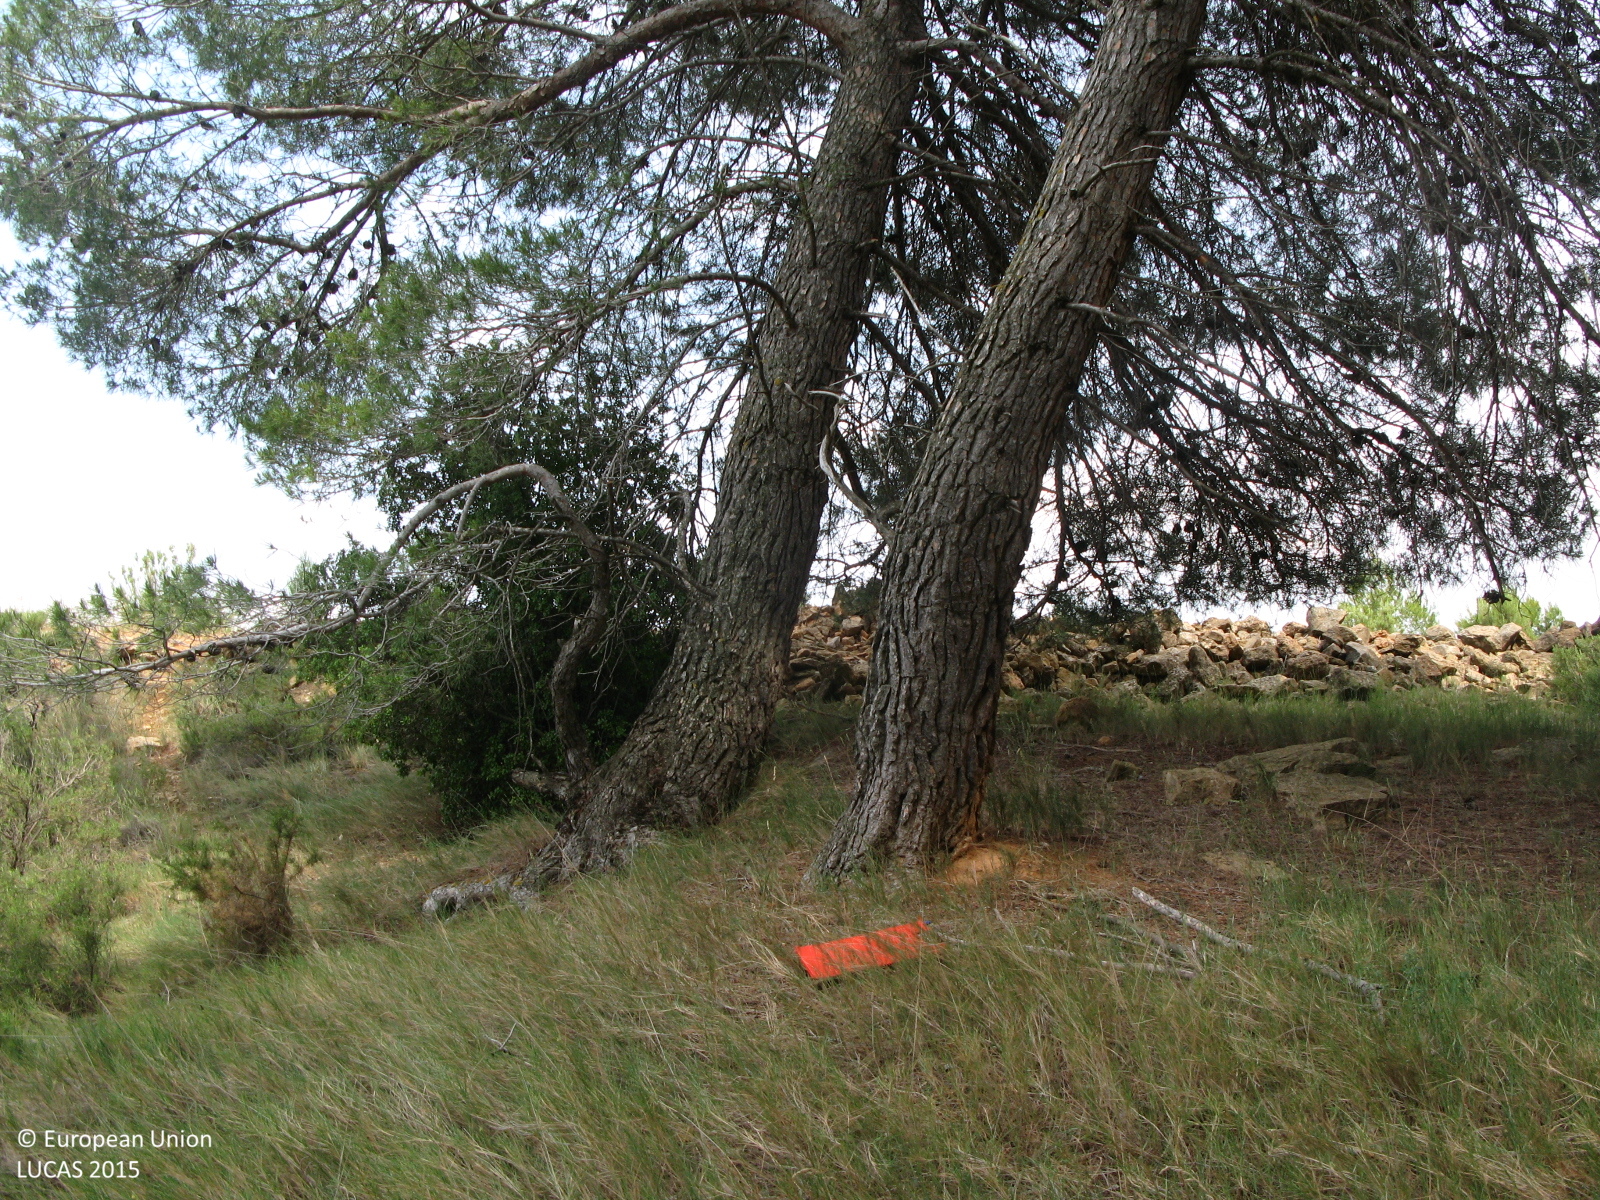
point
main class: Woodland
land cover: Pine dominated coniferous woodland
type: coniferous forest of the mediterranean region
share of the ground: 25 - 50 %
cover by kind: shrubs 40 %, herbaceous plants 30 %, coniferous forest trees 25 %, broadleaved forest trees 5 %
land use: Forestry
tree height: > 5 m
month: June
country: ES
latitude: 39.8320
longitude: -0.9762
